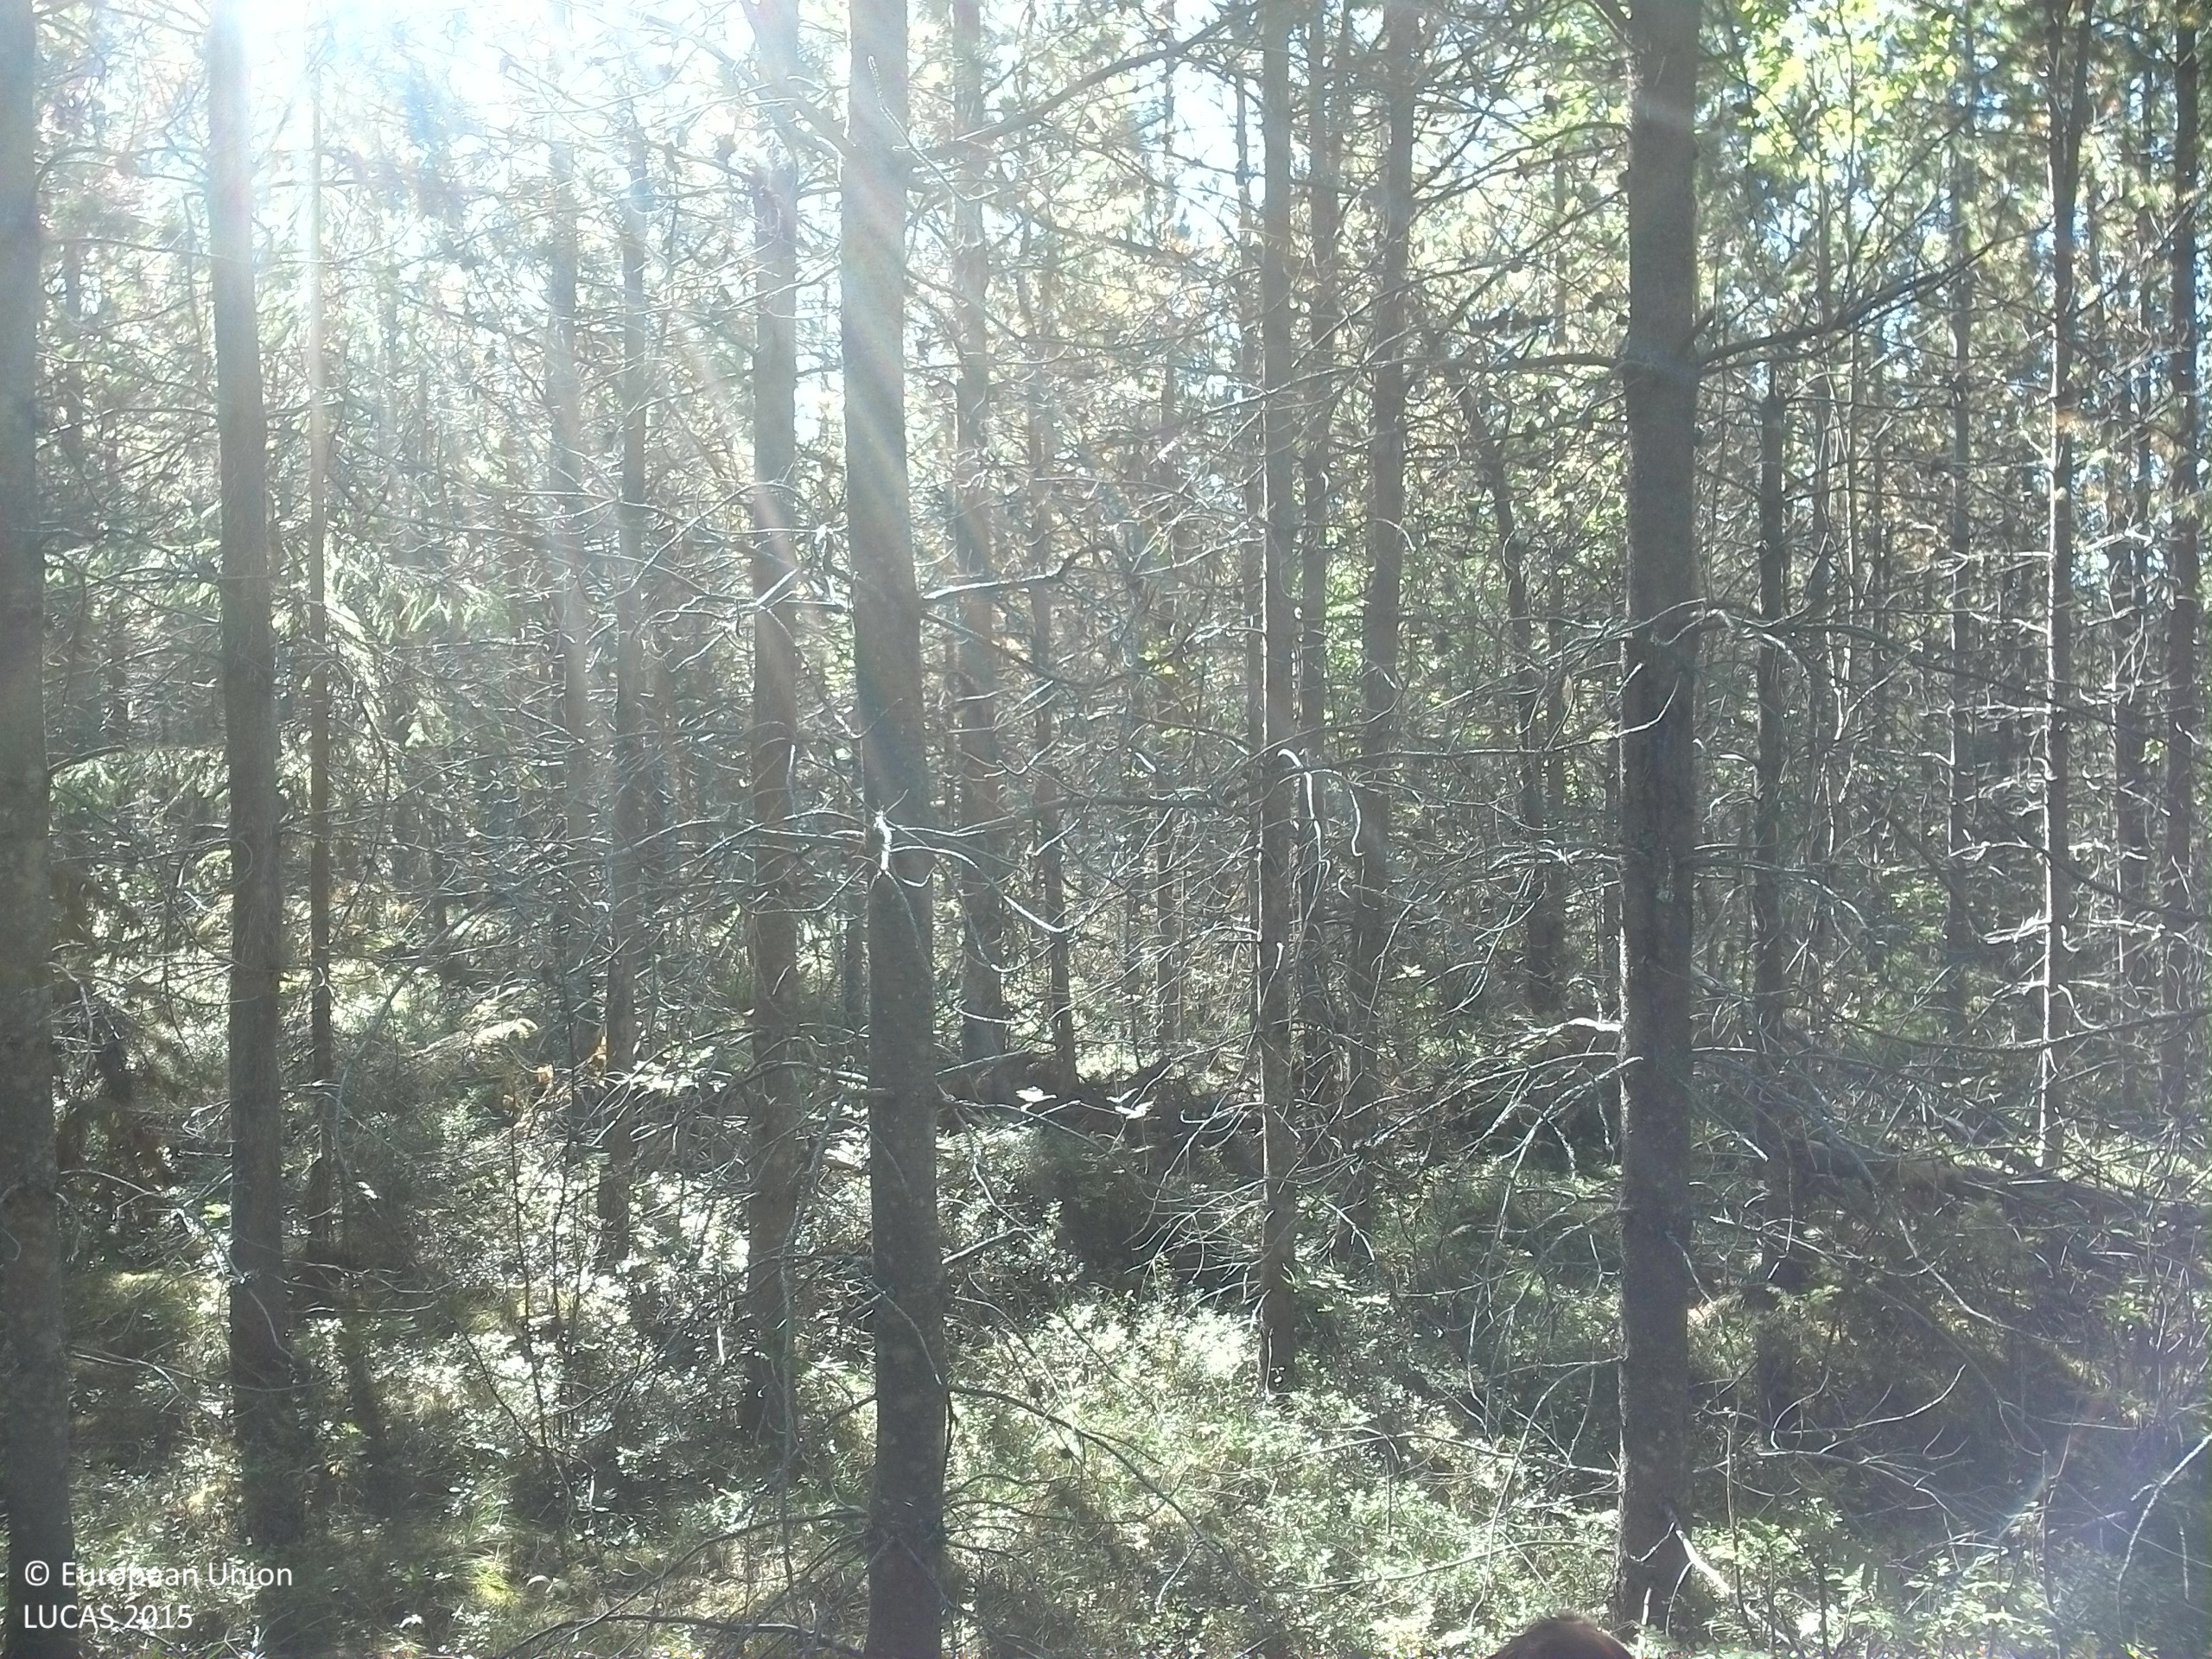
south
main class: Woodland
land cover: Pine dominated coniferous woodland
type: exotic forest
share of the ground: > 75 %
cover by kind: coniferous forest trees 80 %, shrubs 20 %
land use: Forestry
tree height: > 5 m
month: August
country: SE
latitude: 63.9267
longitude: 17.5776
